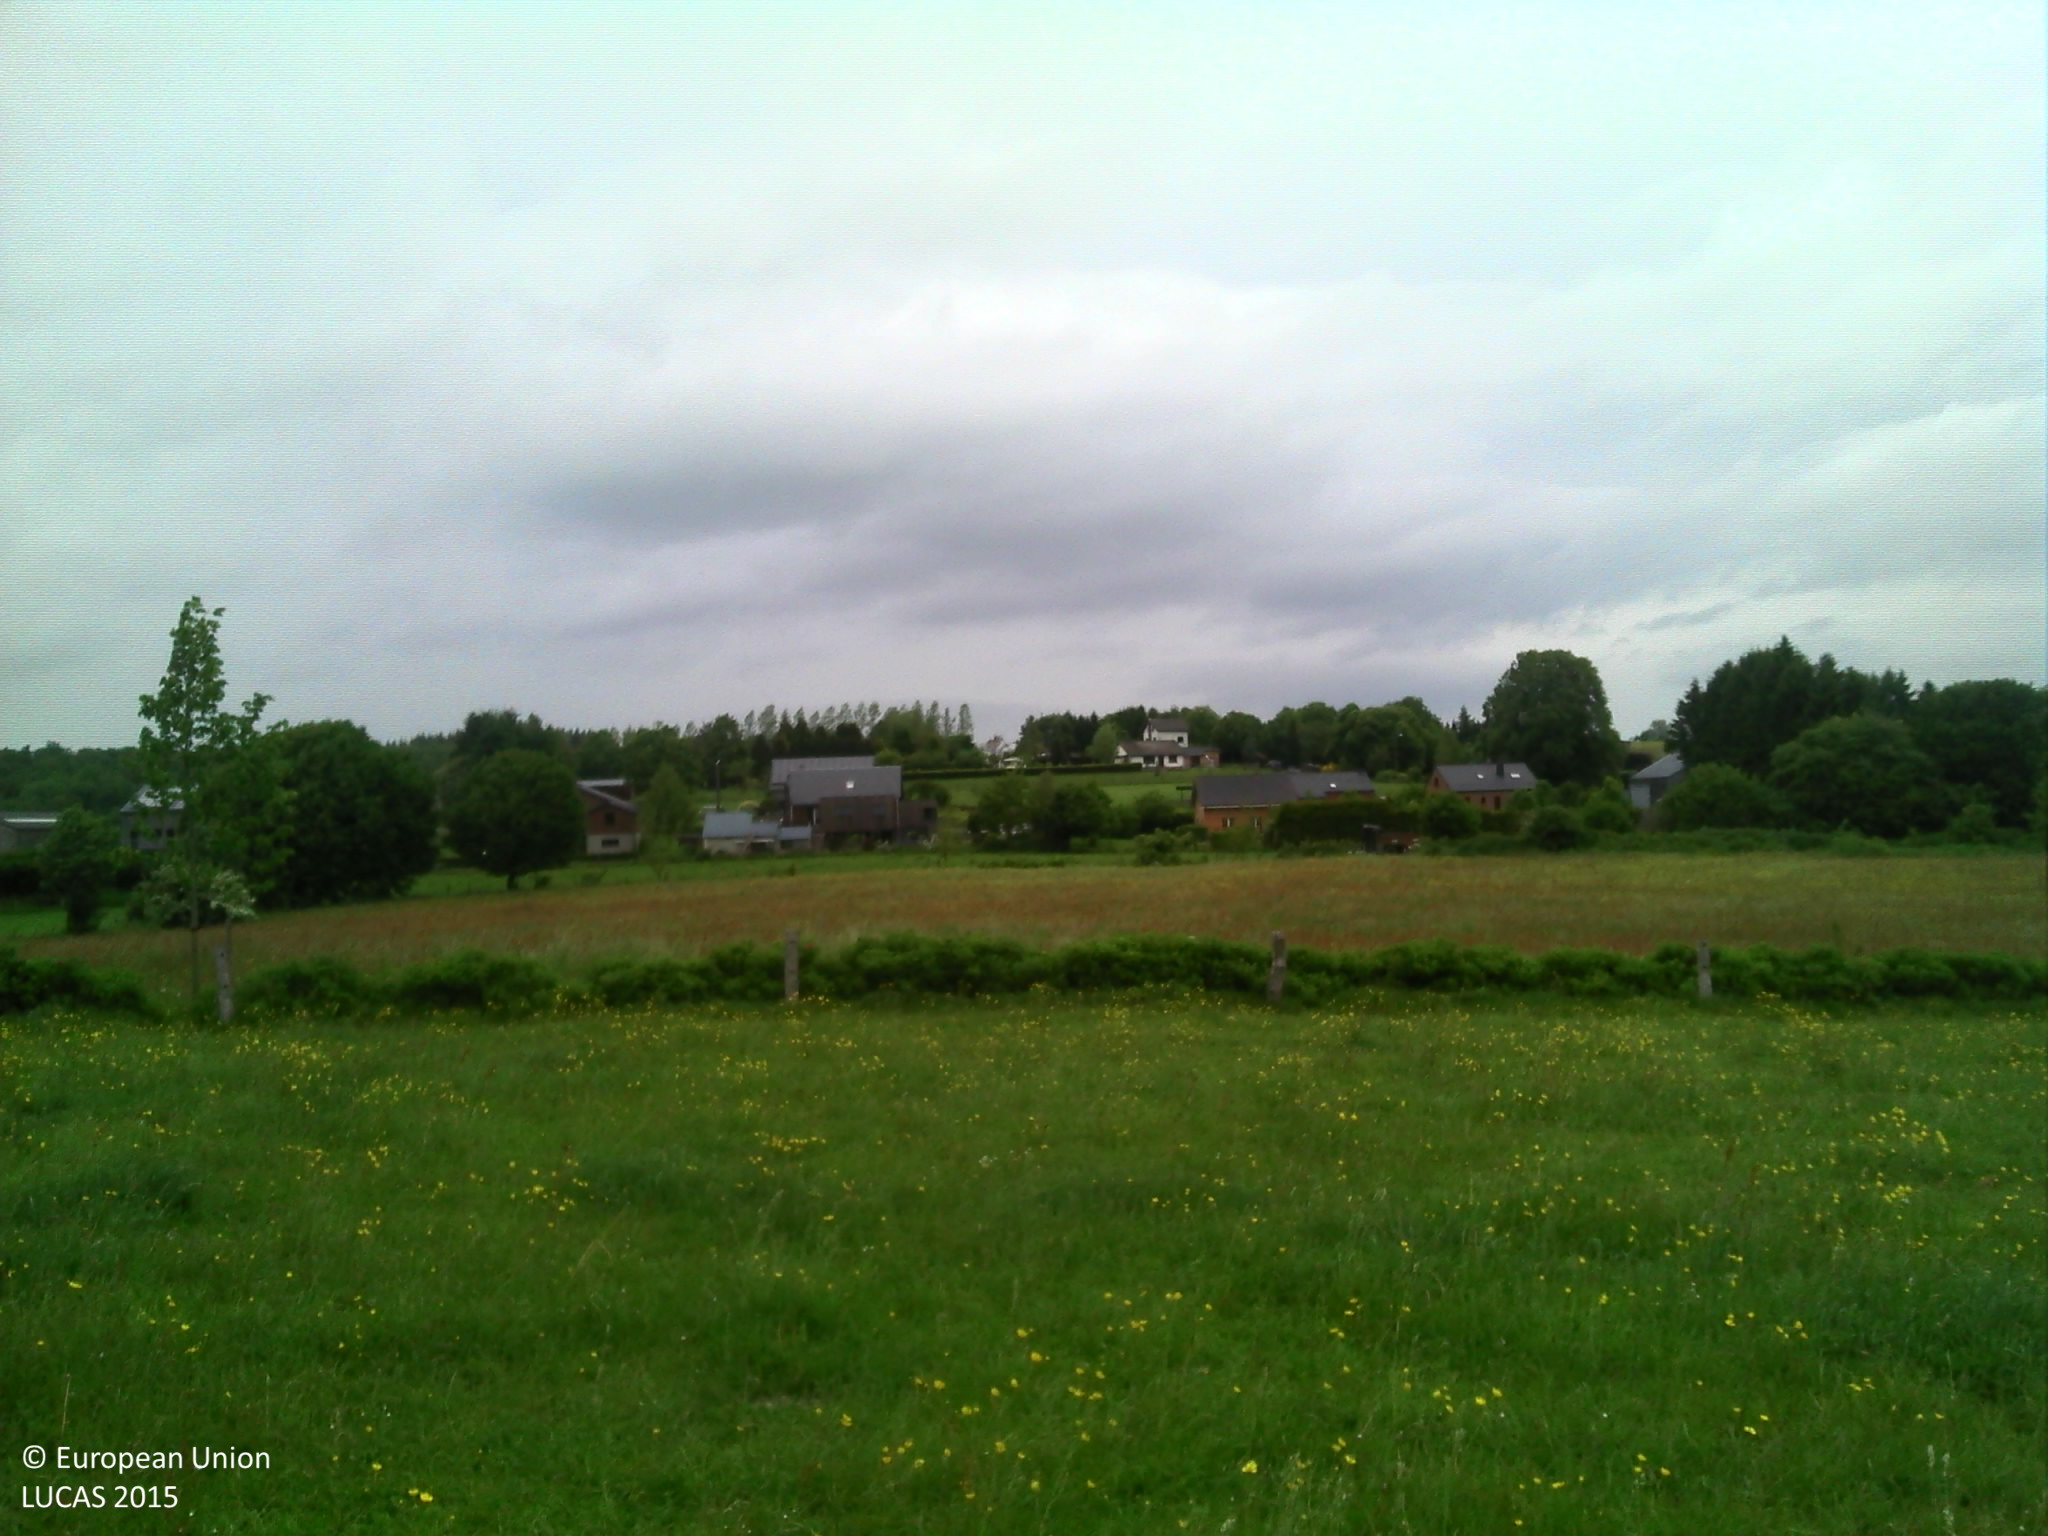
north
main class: Grassland
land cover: Grassland without tree/shrub cover
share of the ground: > 75 %
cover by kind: herbaceous plants 100 %
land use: Agriculture (excluding fallow land and kitchen gardens)
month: June
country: BE
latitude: 49.9087
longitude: 4.9146
